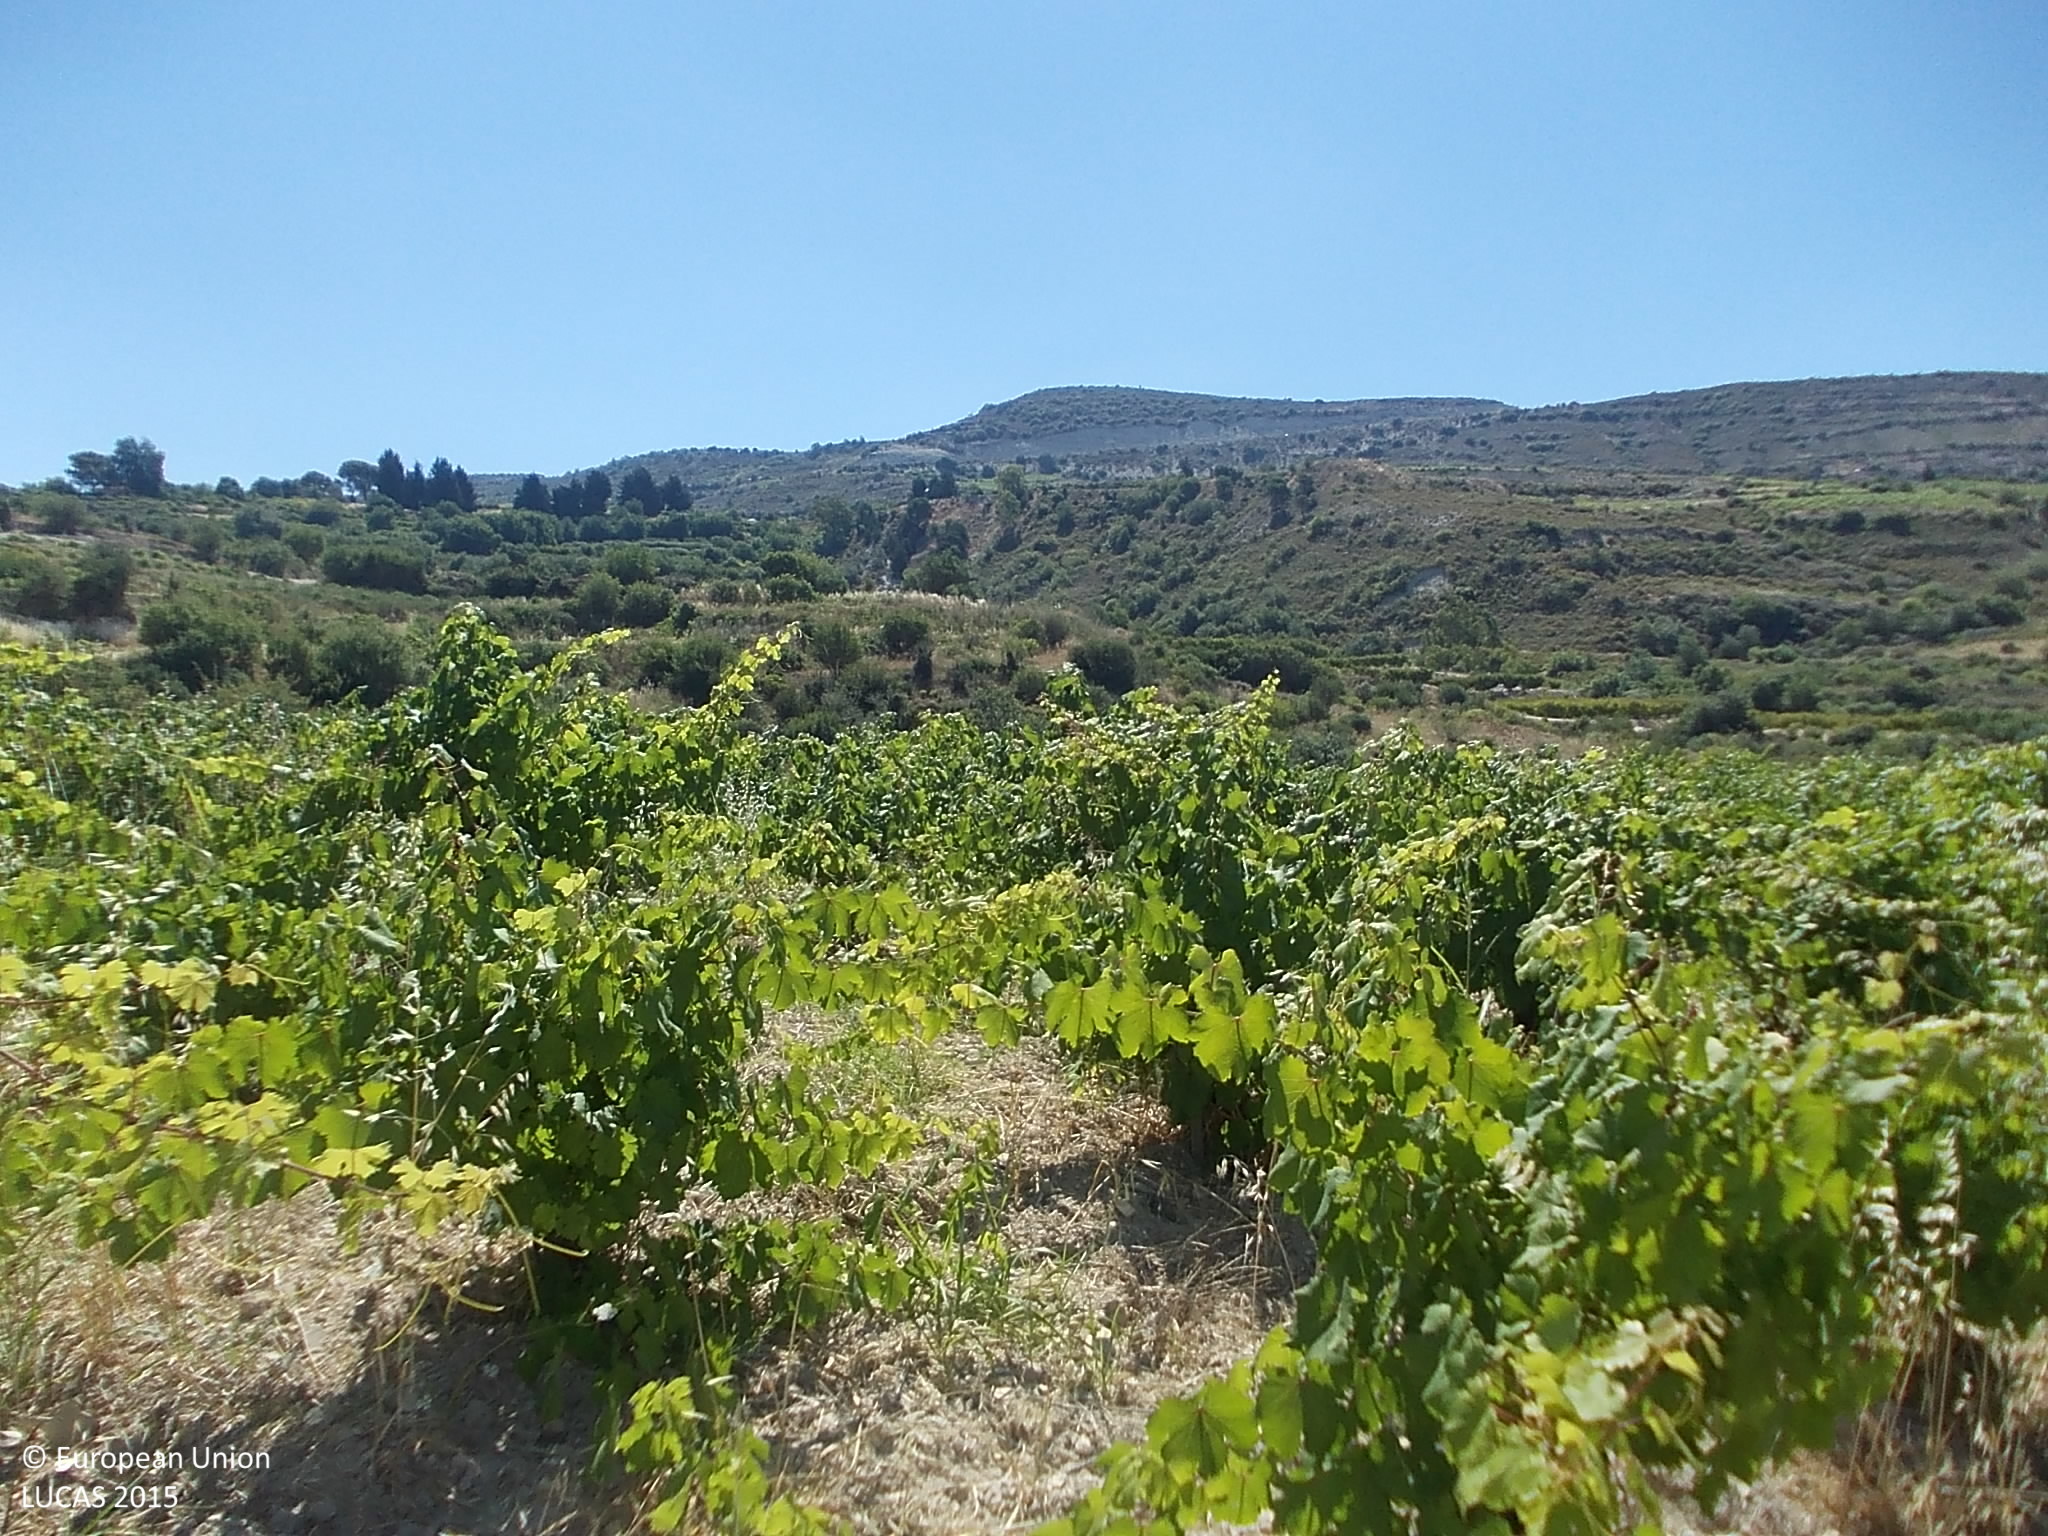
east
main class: Cropland
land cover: Vineyards
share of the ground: 25 - 50 %
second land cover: Other bare soil
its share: > 75 %
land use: Agriculture (excluding fallow land and kitchen gardens)
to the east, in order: Vineyards; Other bare soil; Tracks; Spontaneously vegetated surfaces; Shrubland without tree cover; Vineyards; Grassland without tree/shrub cover; Vineyards; Shrubland with sparse tree cover; Tracks; Shrubland with sparse tree cover; Other bare soil
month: July
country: CY
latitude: 34.8585
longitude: 32.7463
